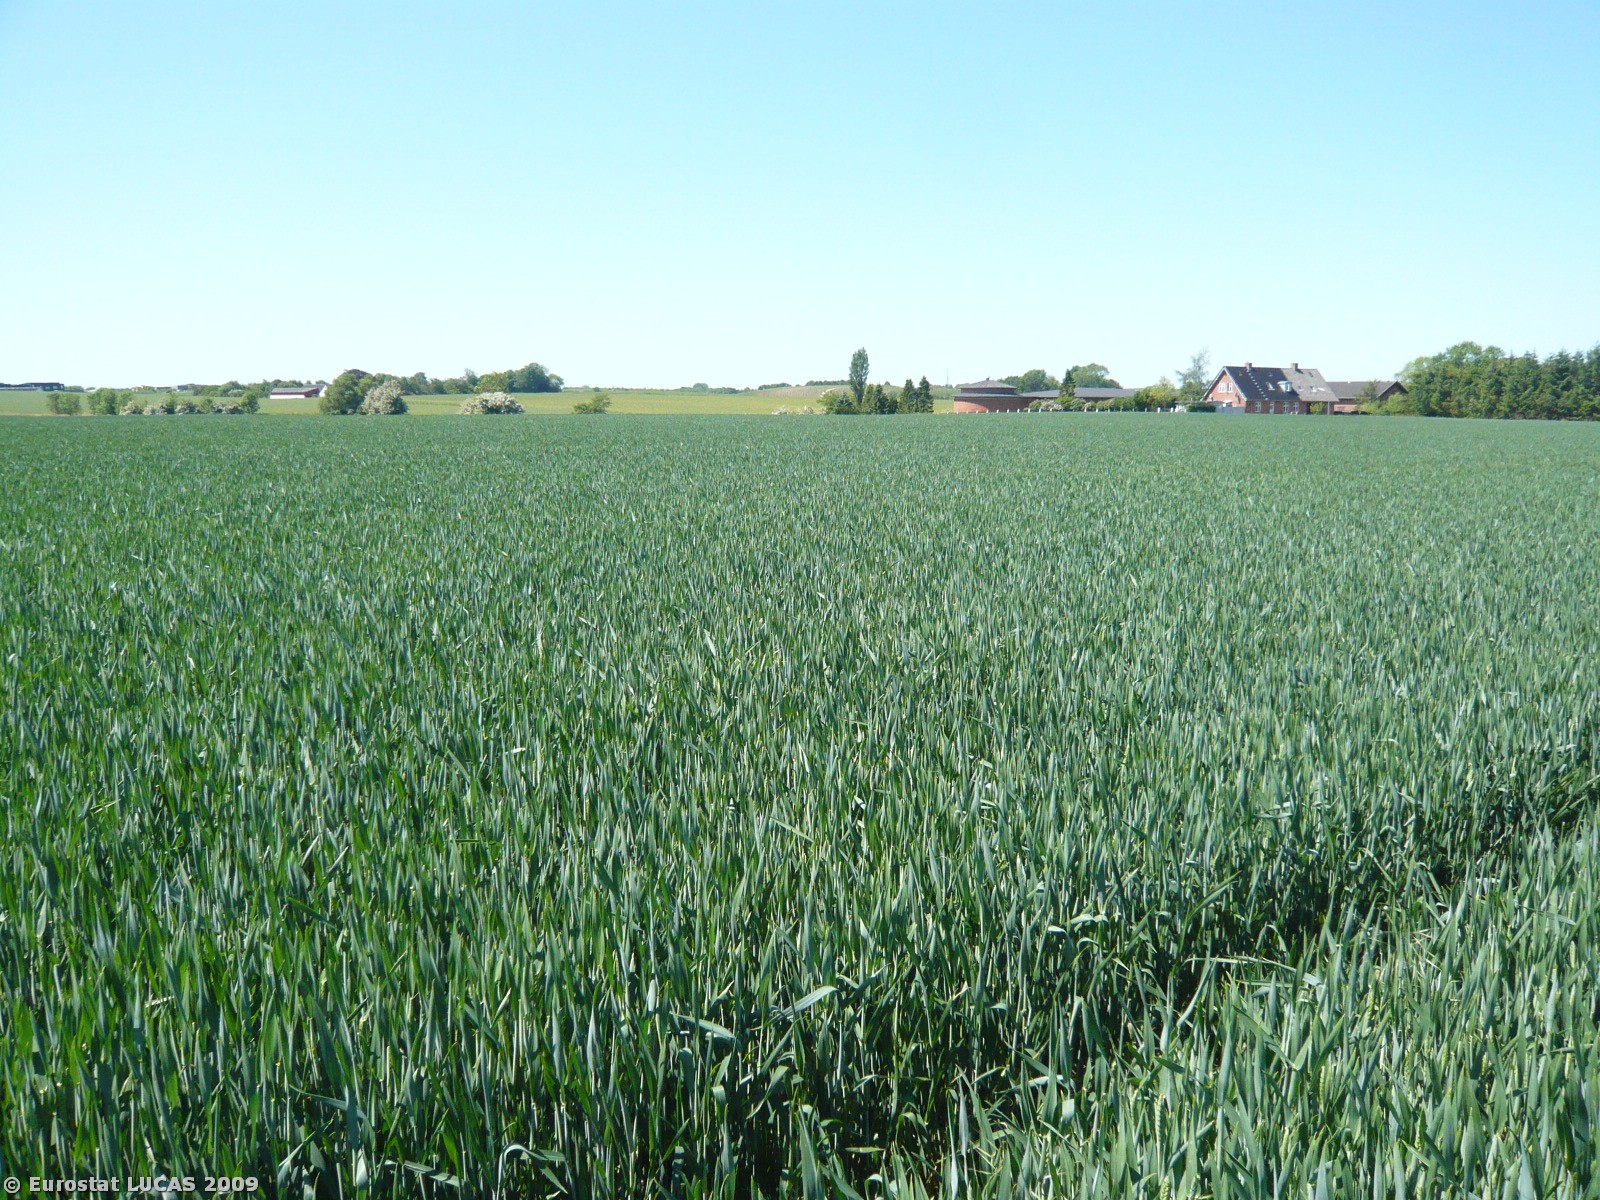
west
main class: Cropland
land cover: Common wheat
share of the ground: > 75 %
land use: Agriculture (excluding fallow land and kitchen gardens)
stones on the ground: < 10 %
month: June
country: DK
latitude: 55.6664
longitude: 12.1444
